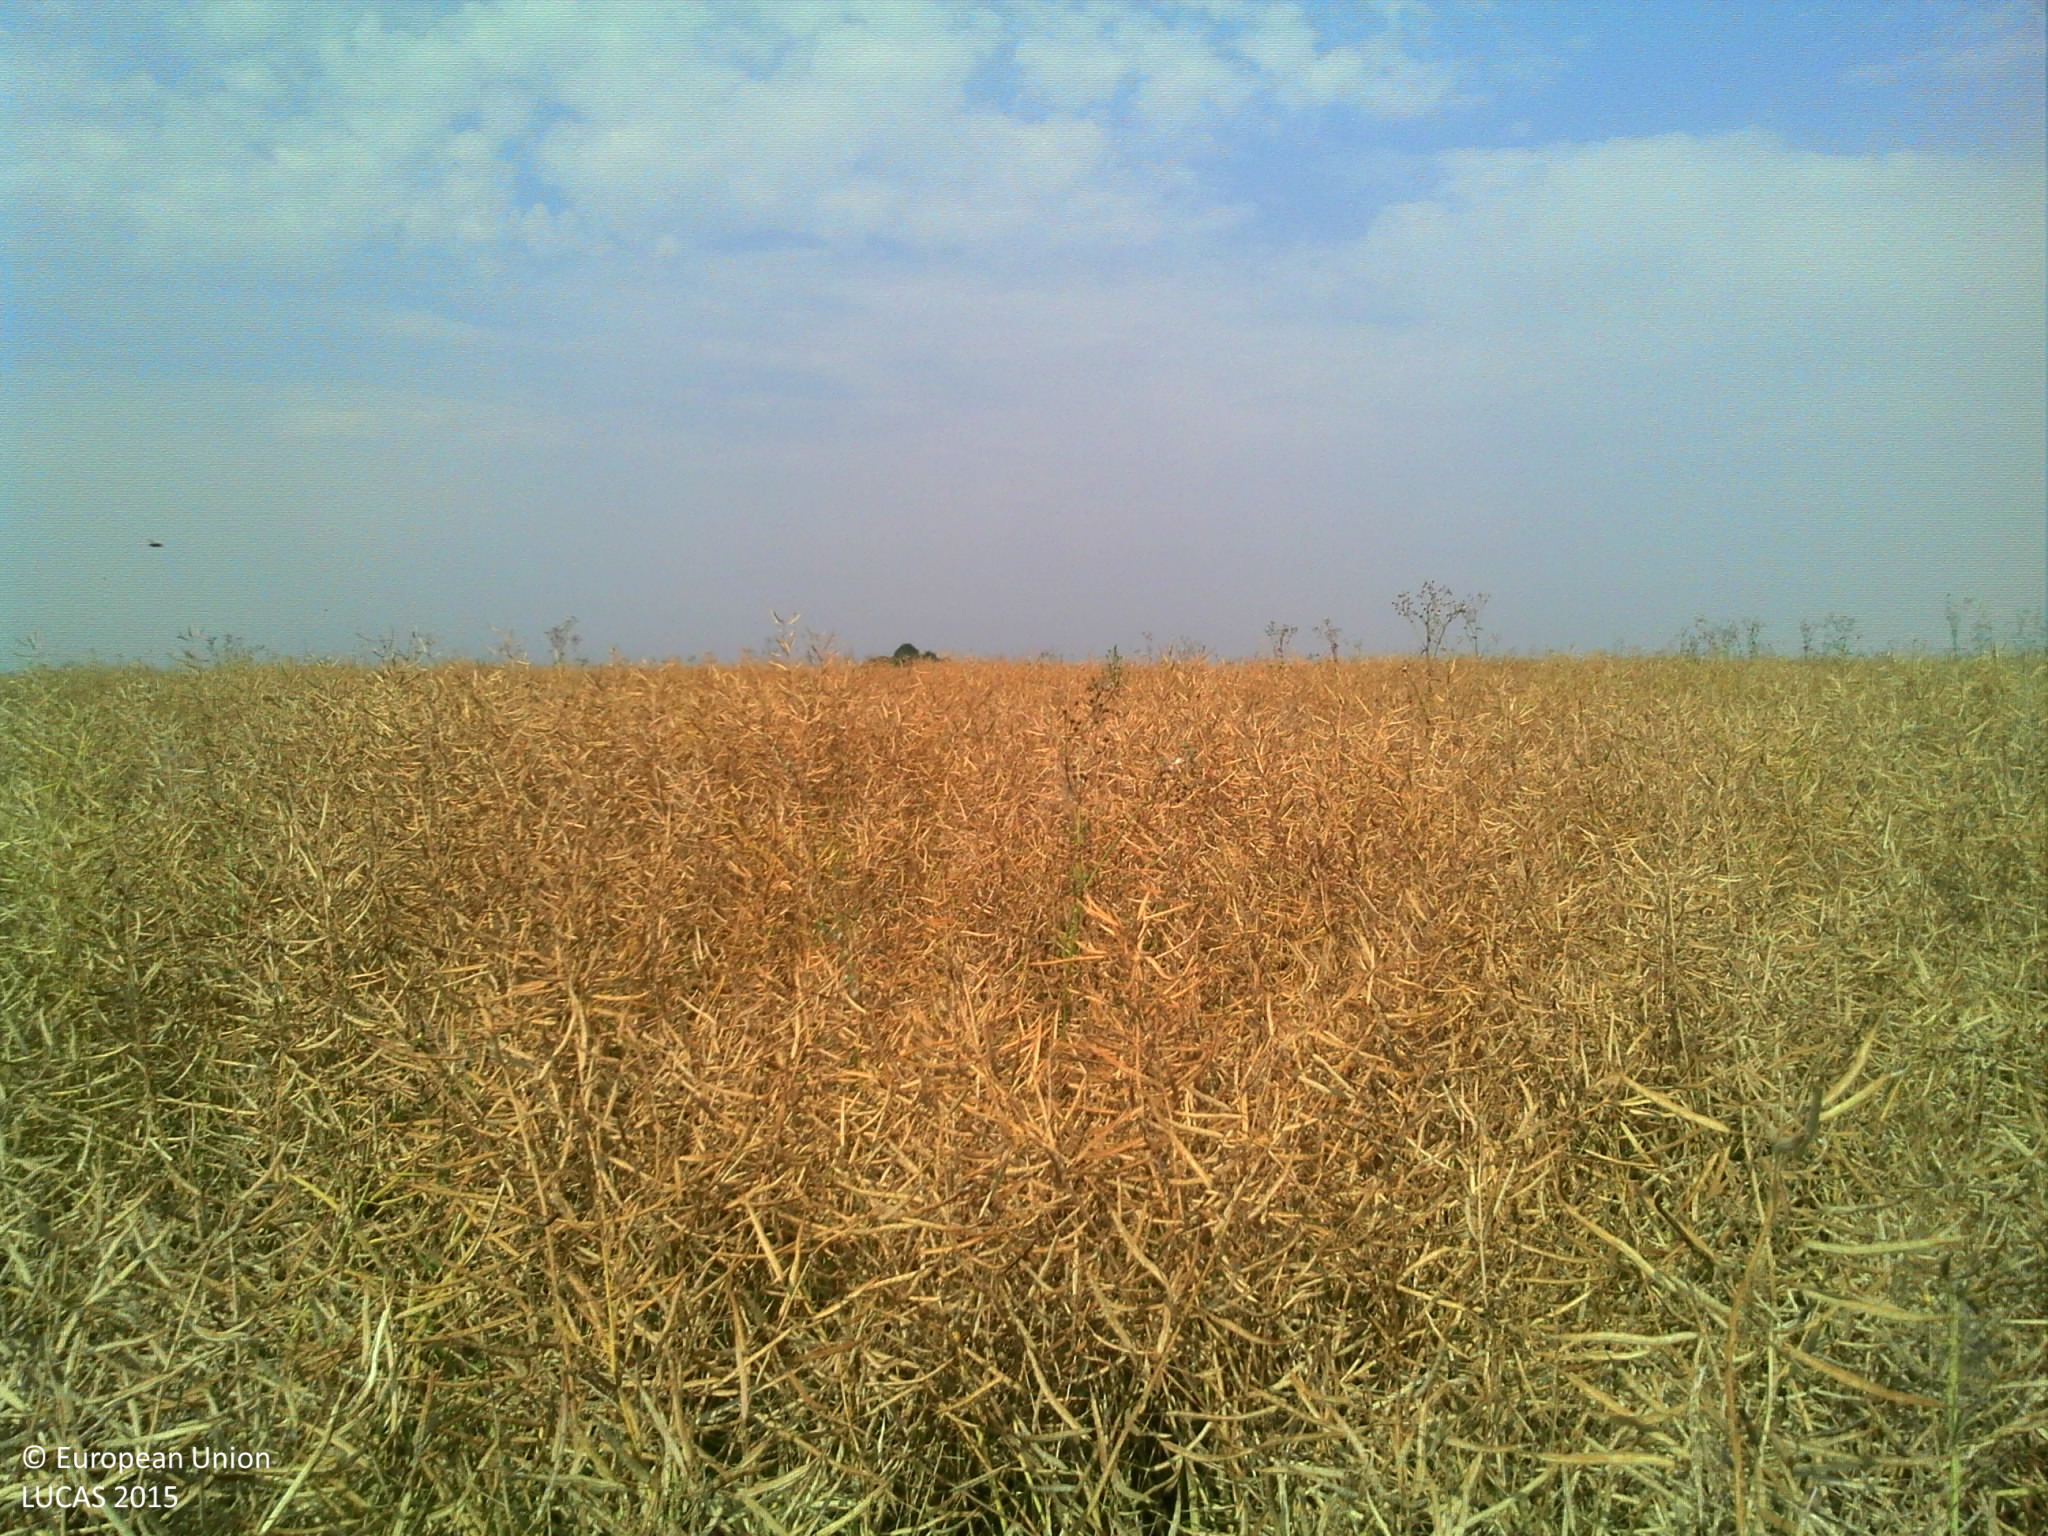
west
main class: Cropland
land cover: Rape and turnip rape
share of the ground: > 75 %
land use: Agriculture (excluding fallow land and kitchen gardens)
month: July
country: FR
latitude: 47.8463
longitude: 2.8434
